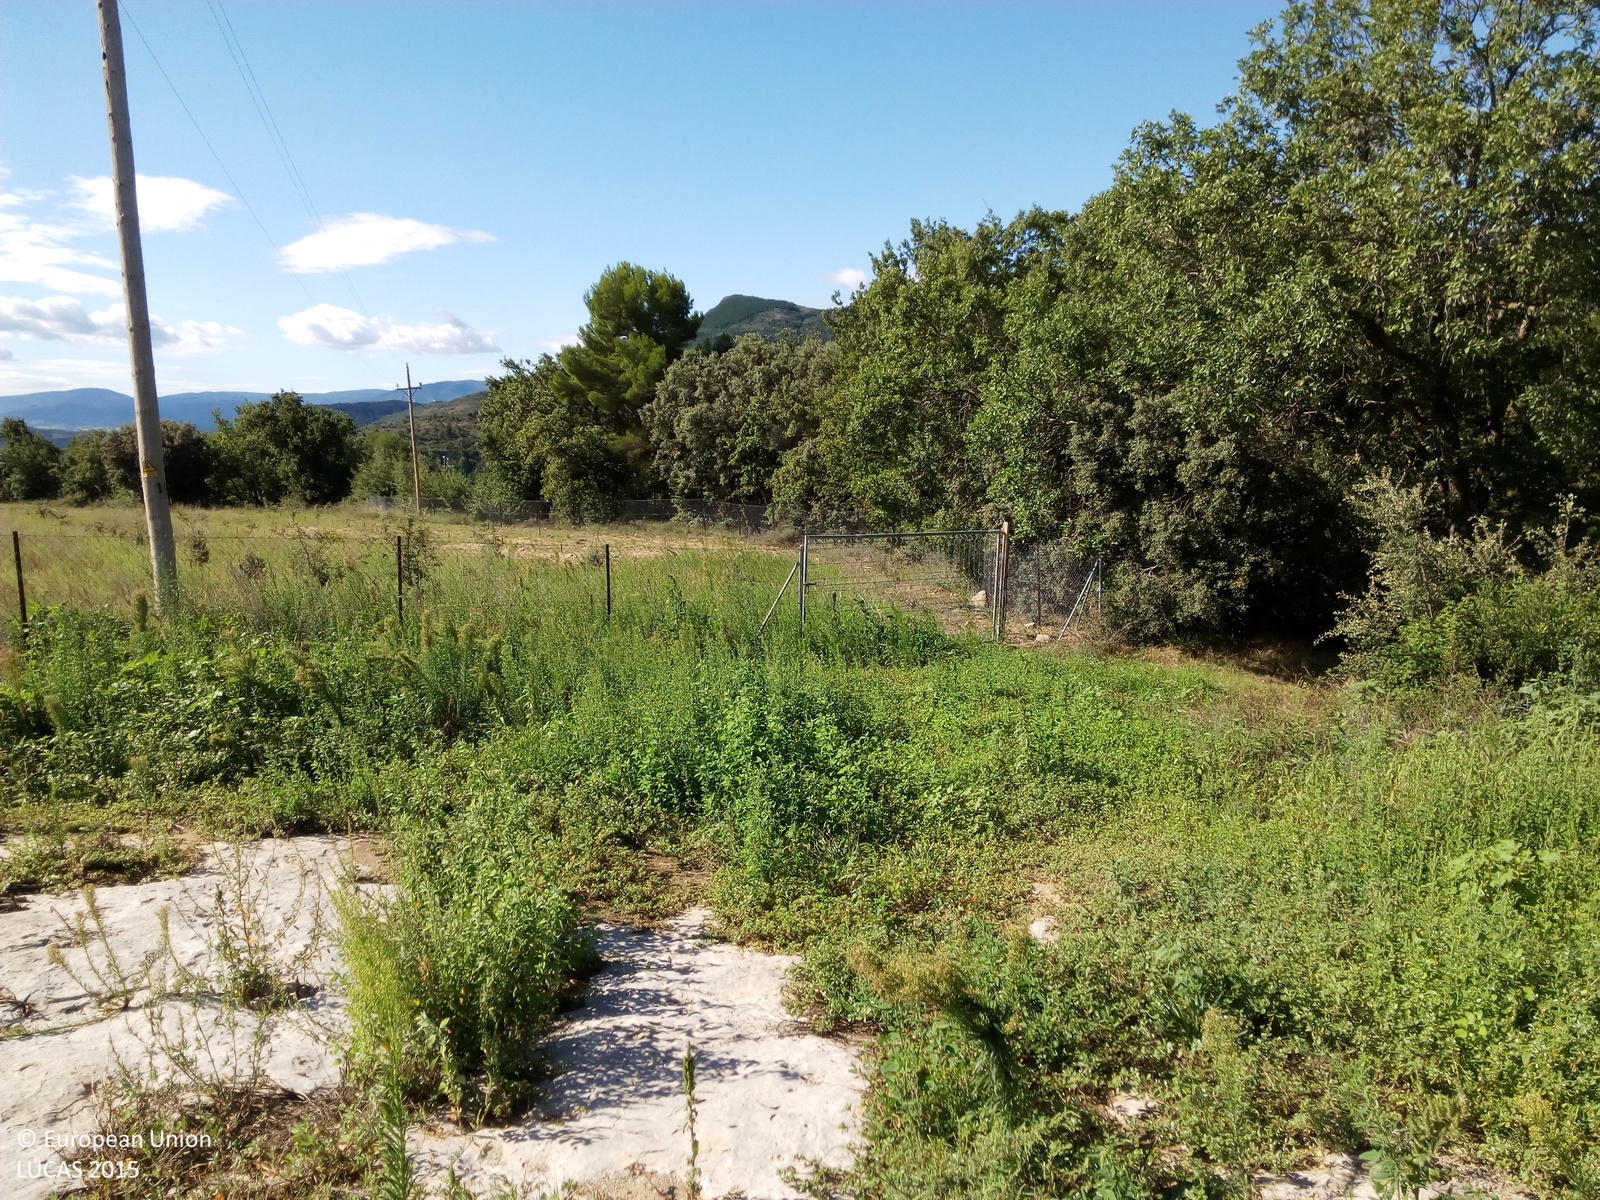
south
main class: Grassland
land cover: Grassland without tree/shrub cover
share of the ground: > 75 %
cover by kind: herbaceous plants 100 %
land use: Semi-natural and natural areas not in use
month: August
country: ES
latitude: 42.2441
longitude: 0.3222
